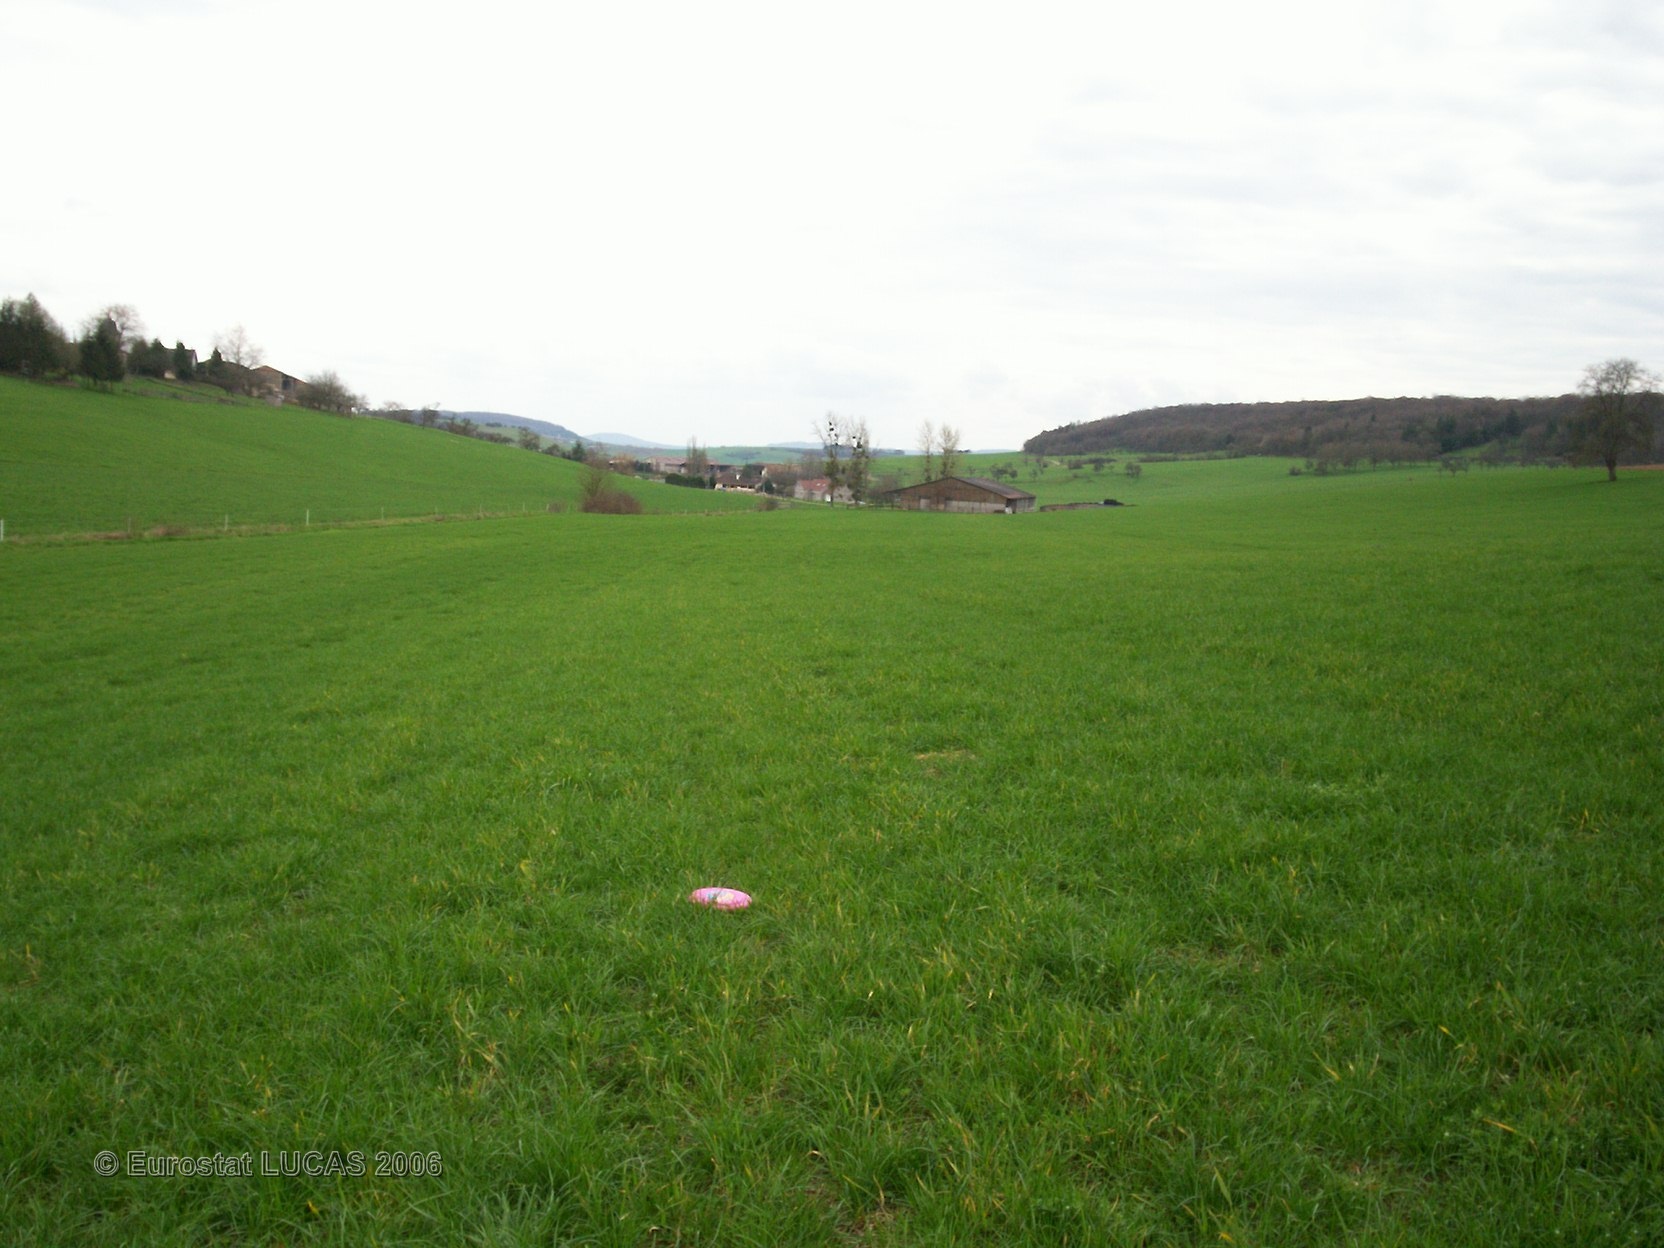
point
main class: Cropland
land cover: Other leguminous and mixtures for fodder
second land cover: Clovers
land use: Agriculture (excluding fallow land and kitchen gardens)
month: April
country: FR
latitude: 48.2571
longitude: 5.9459
